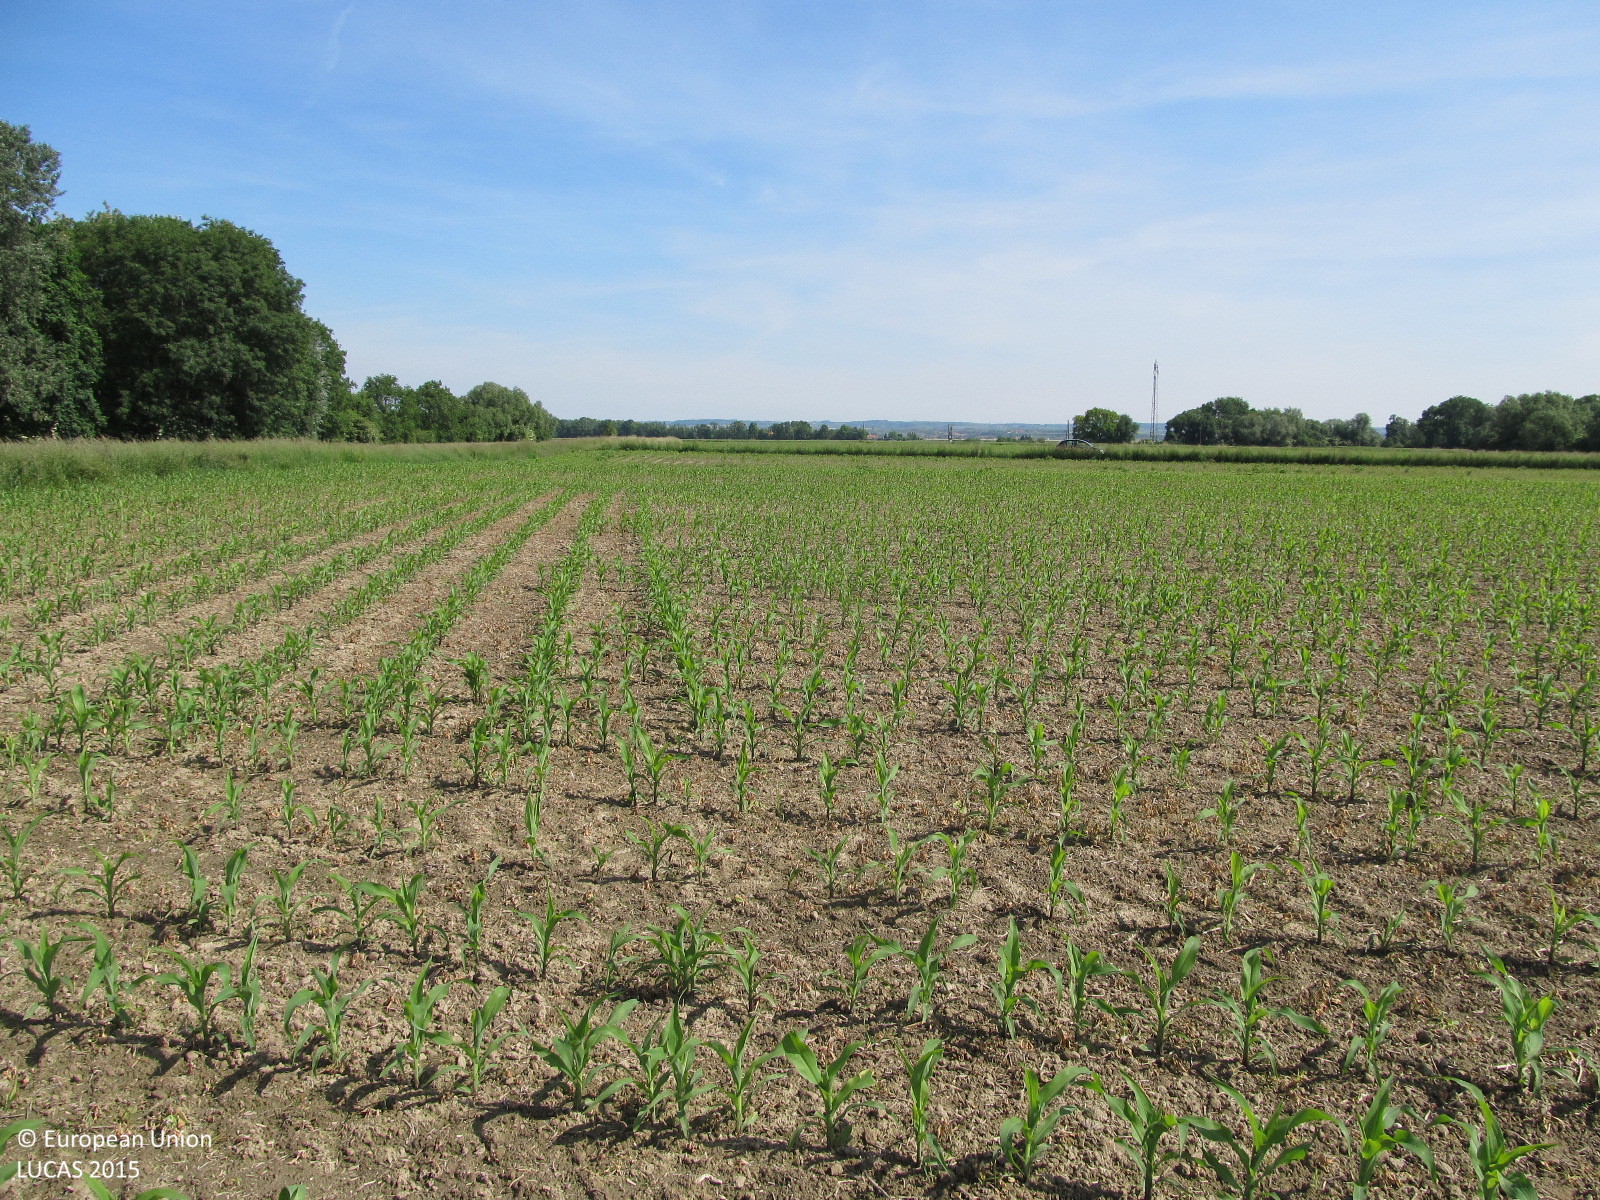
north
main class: Cropland
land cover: Maize
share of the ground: < 10 %
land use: Agriculture (excluding fallow land and kitchen gardens)
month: May
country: AT
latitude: 48.3929
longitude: 15.8514
